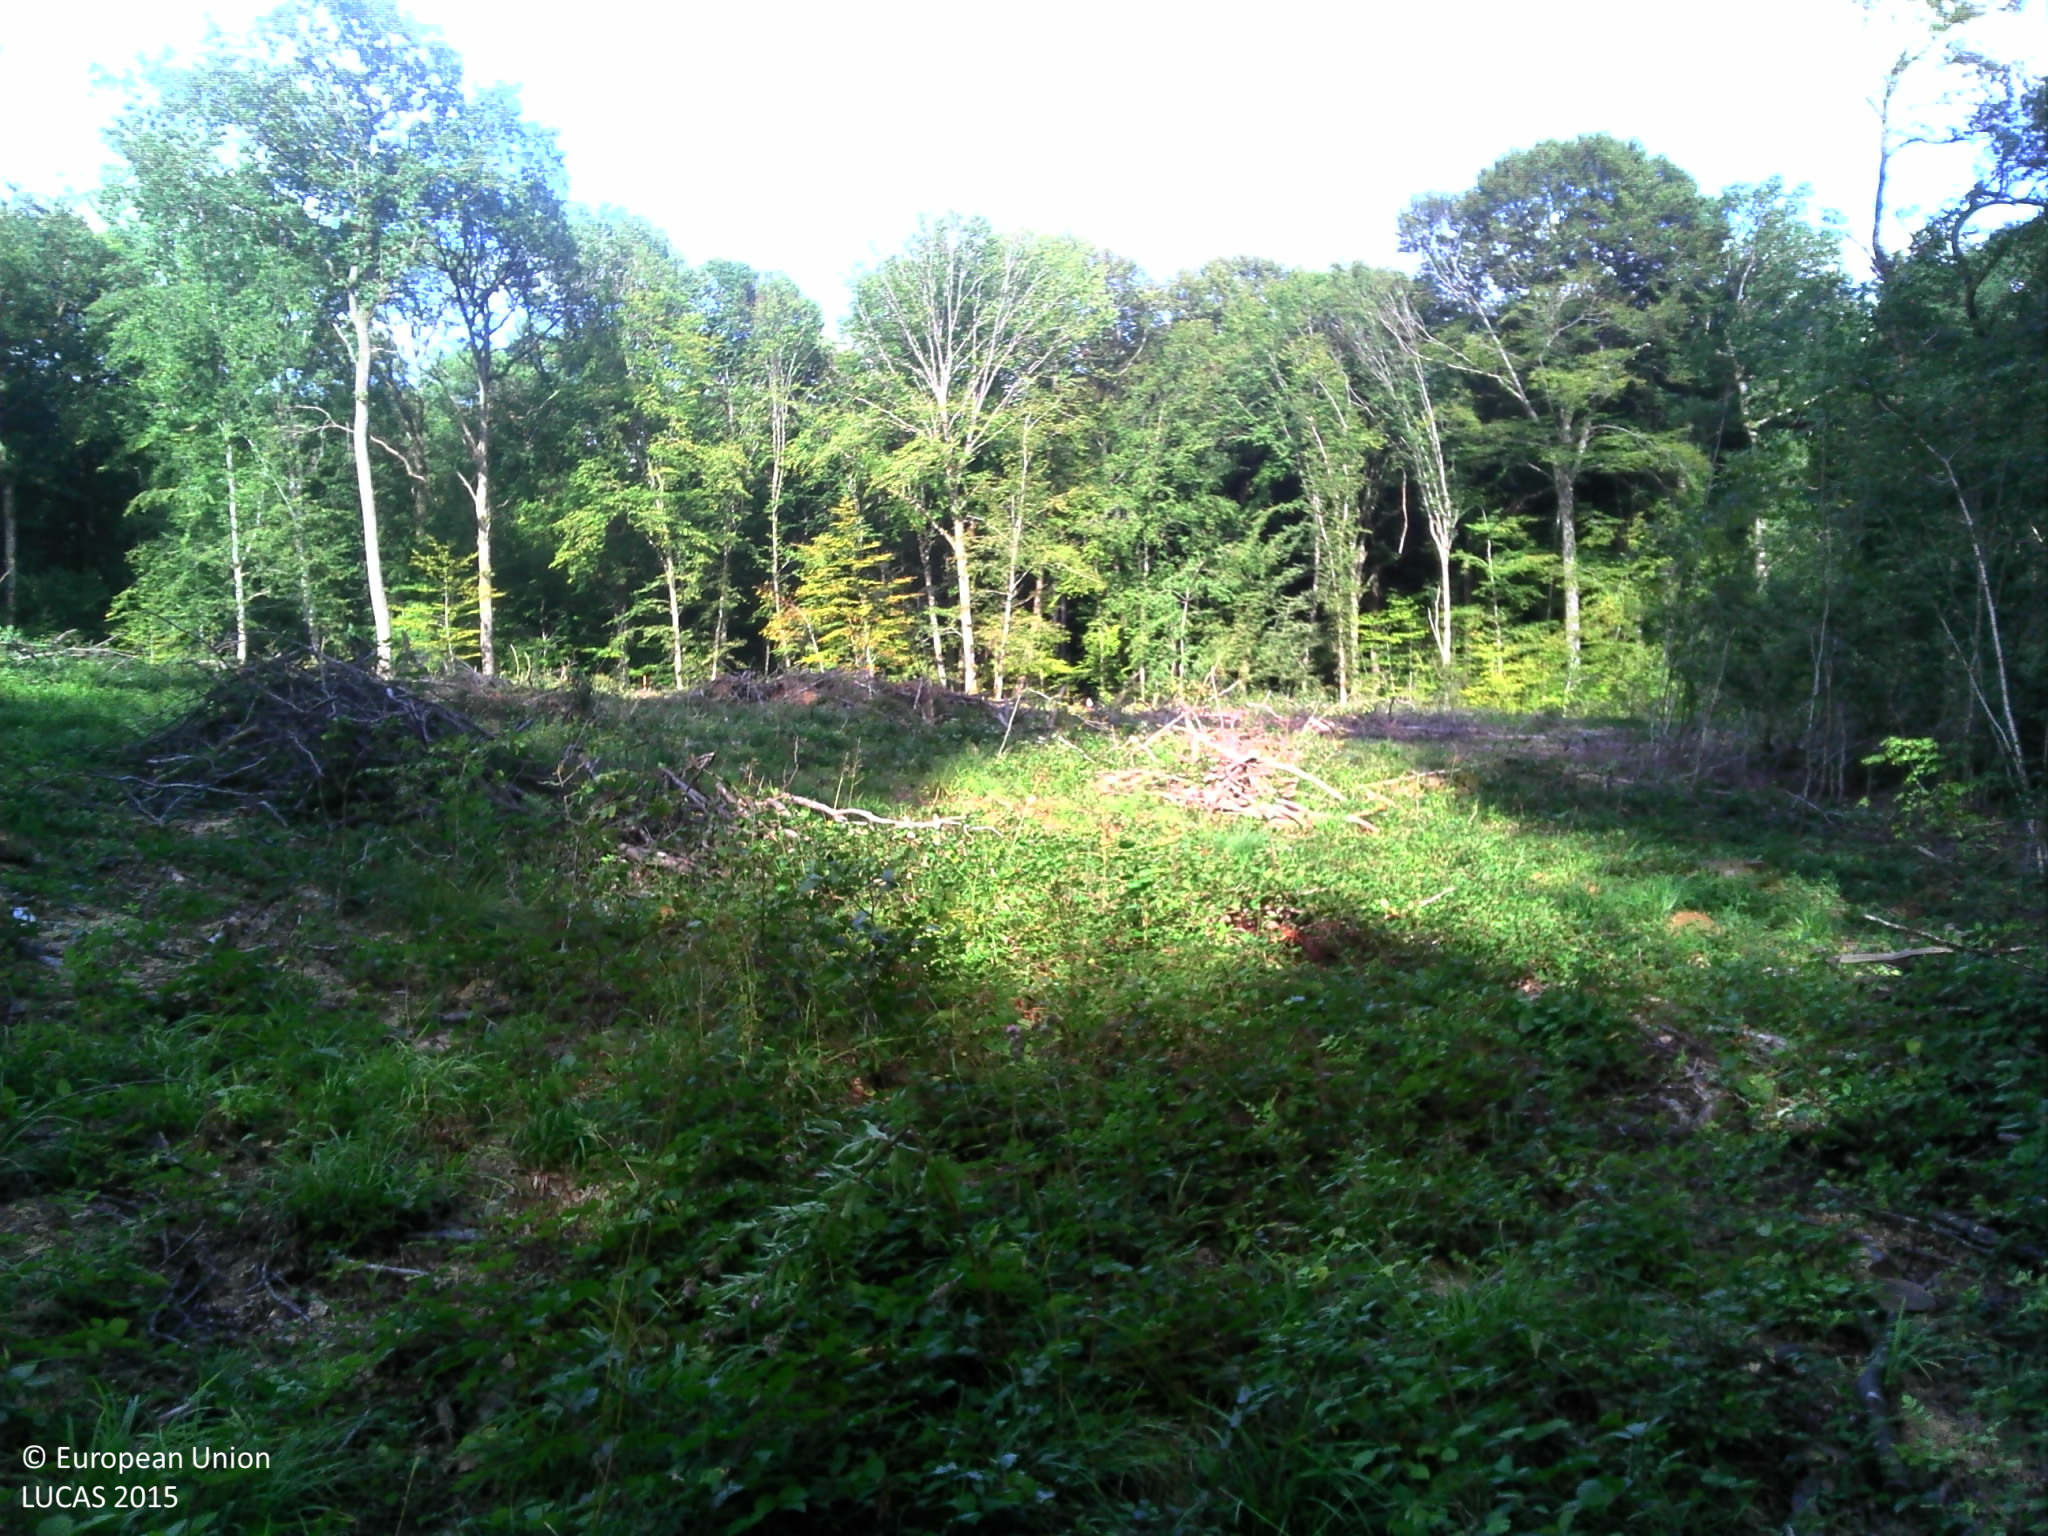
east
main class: Grassland
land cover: Spontaneously vegetated surfaces
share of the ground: > 75 %
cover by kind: herbaceous plants 95 %, shrubs 5 %
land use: Forestry
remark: Clear cut
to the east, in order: Spontaneously vegetated surfaces; Broadleaved woodland; Tracks; Broadleaved woodland; Spruce dominated coniferous woodland
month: September
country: FR
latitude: 47.4256
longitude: 6.3826
